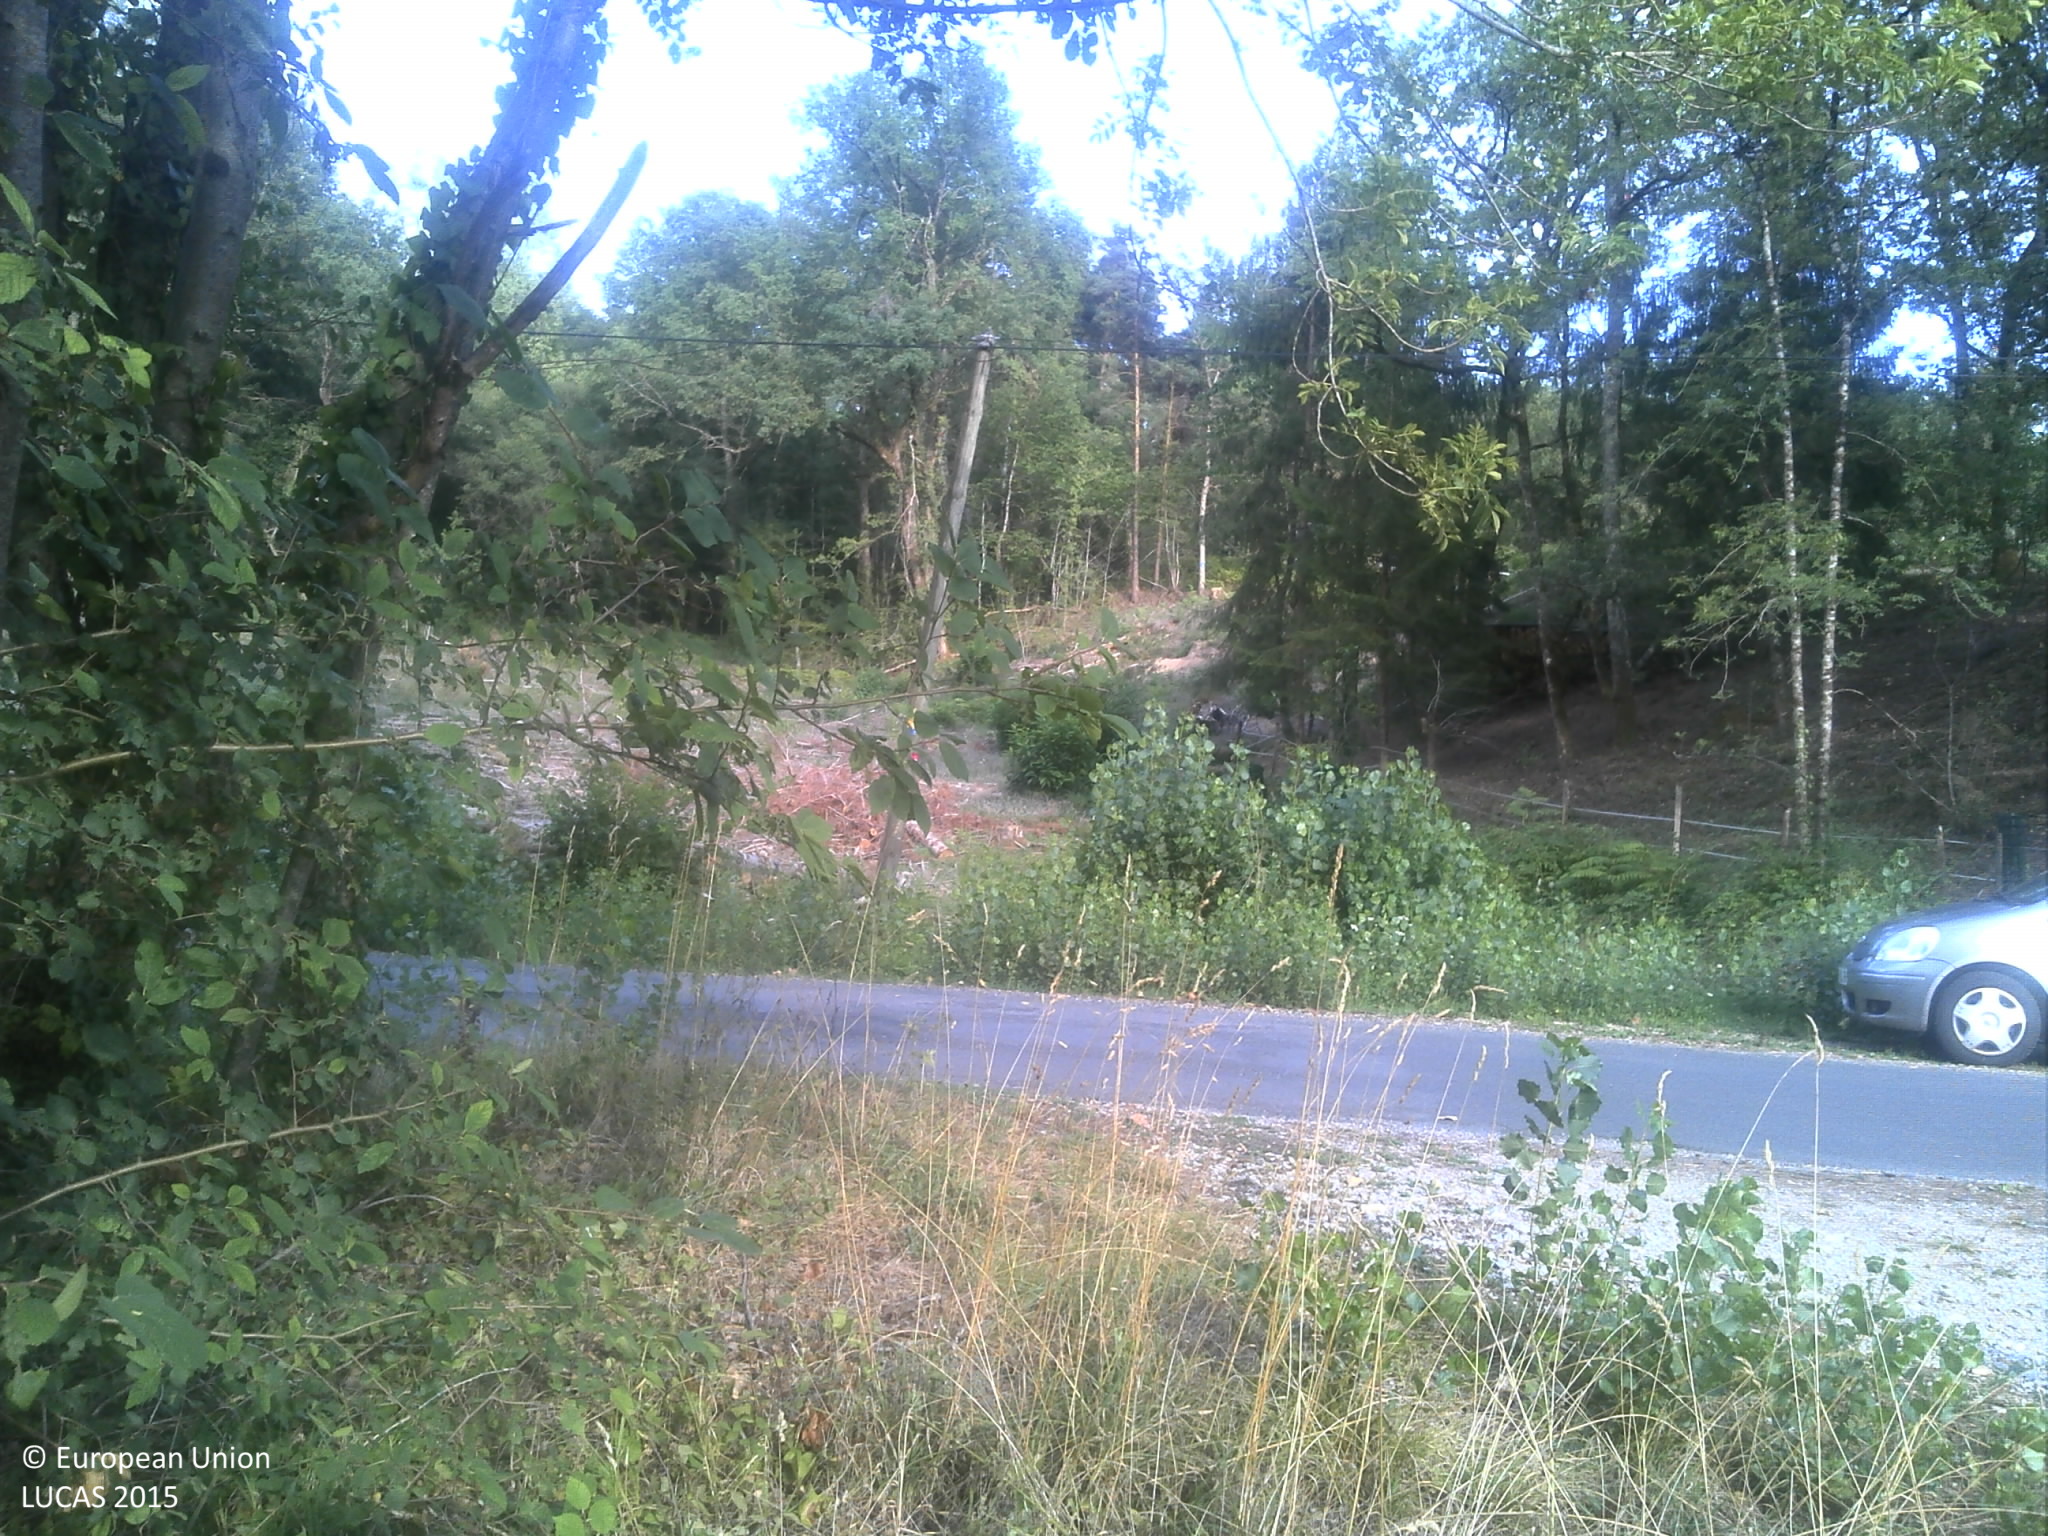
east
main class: Grassland
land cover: Grassland without tree/shrub cover
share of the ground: > 75 %
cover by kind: herbaceous plants 100 %
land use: Agriculture (excluding fallow land and kitchen gardens)
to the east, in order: Grassland without tree/shrub cover; Fences; Managed hedges; Grass margins; Paved roads, cycling and walking lanes; Grass margins; Electric lines; Ditches and canals; Other bare soil; Other mixed woodland; Dry stone walls; Other mixed woodland
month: August
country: FR
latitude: 45.2197
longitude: 1.5521
